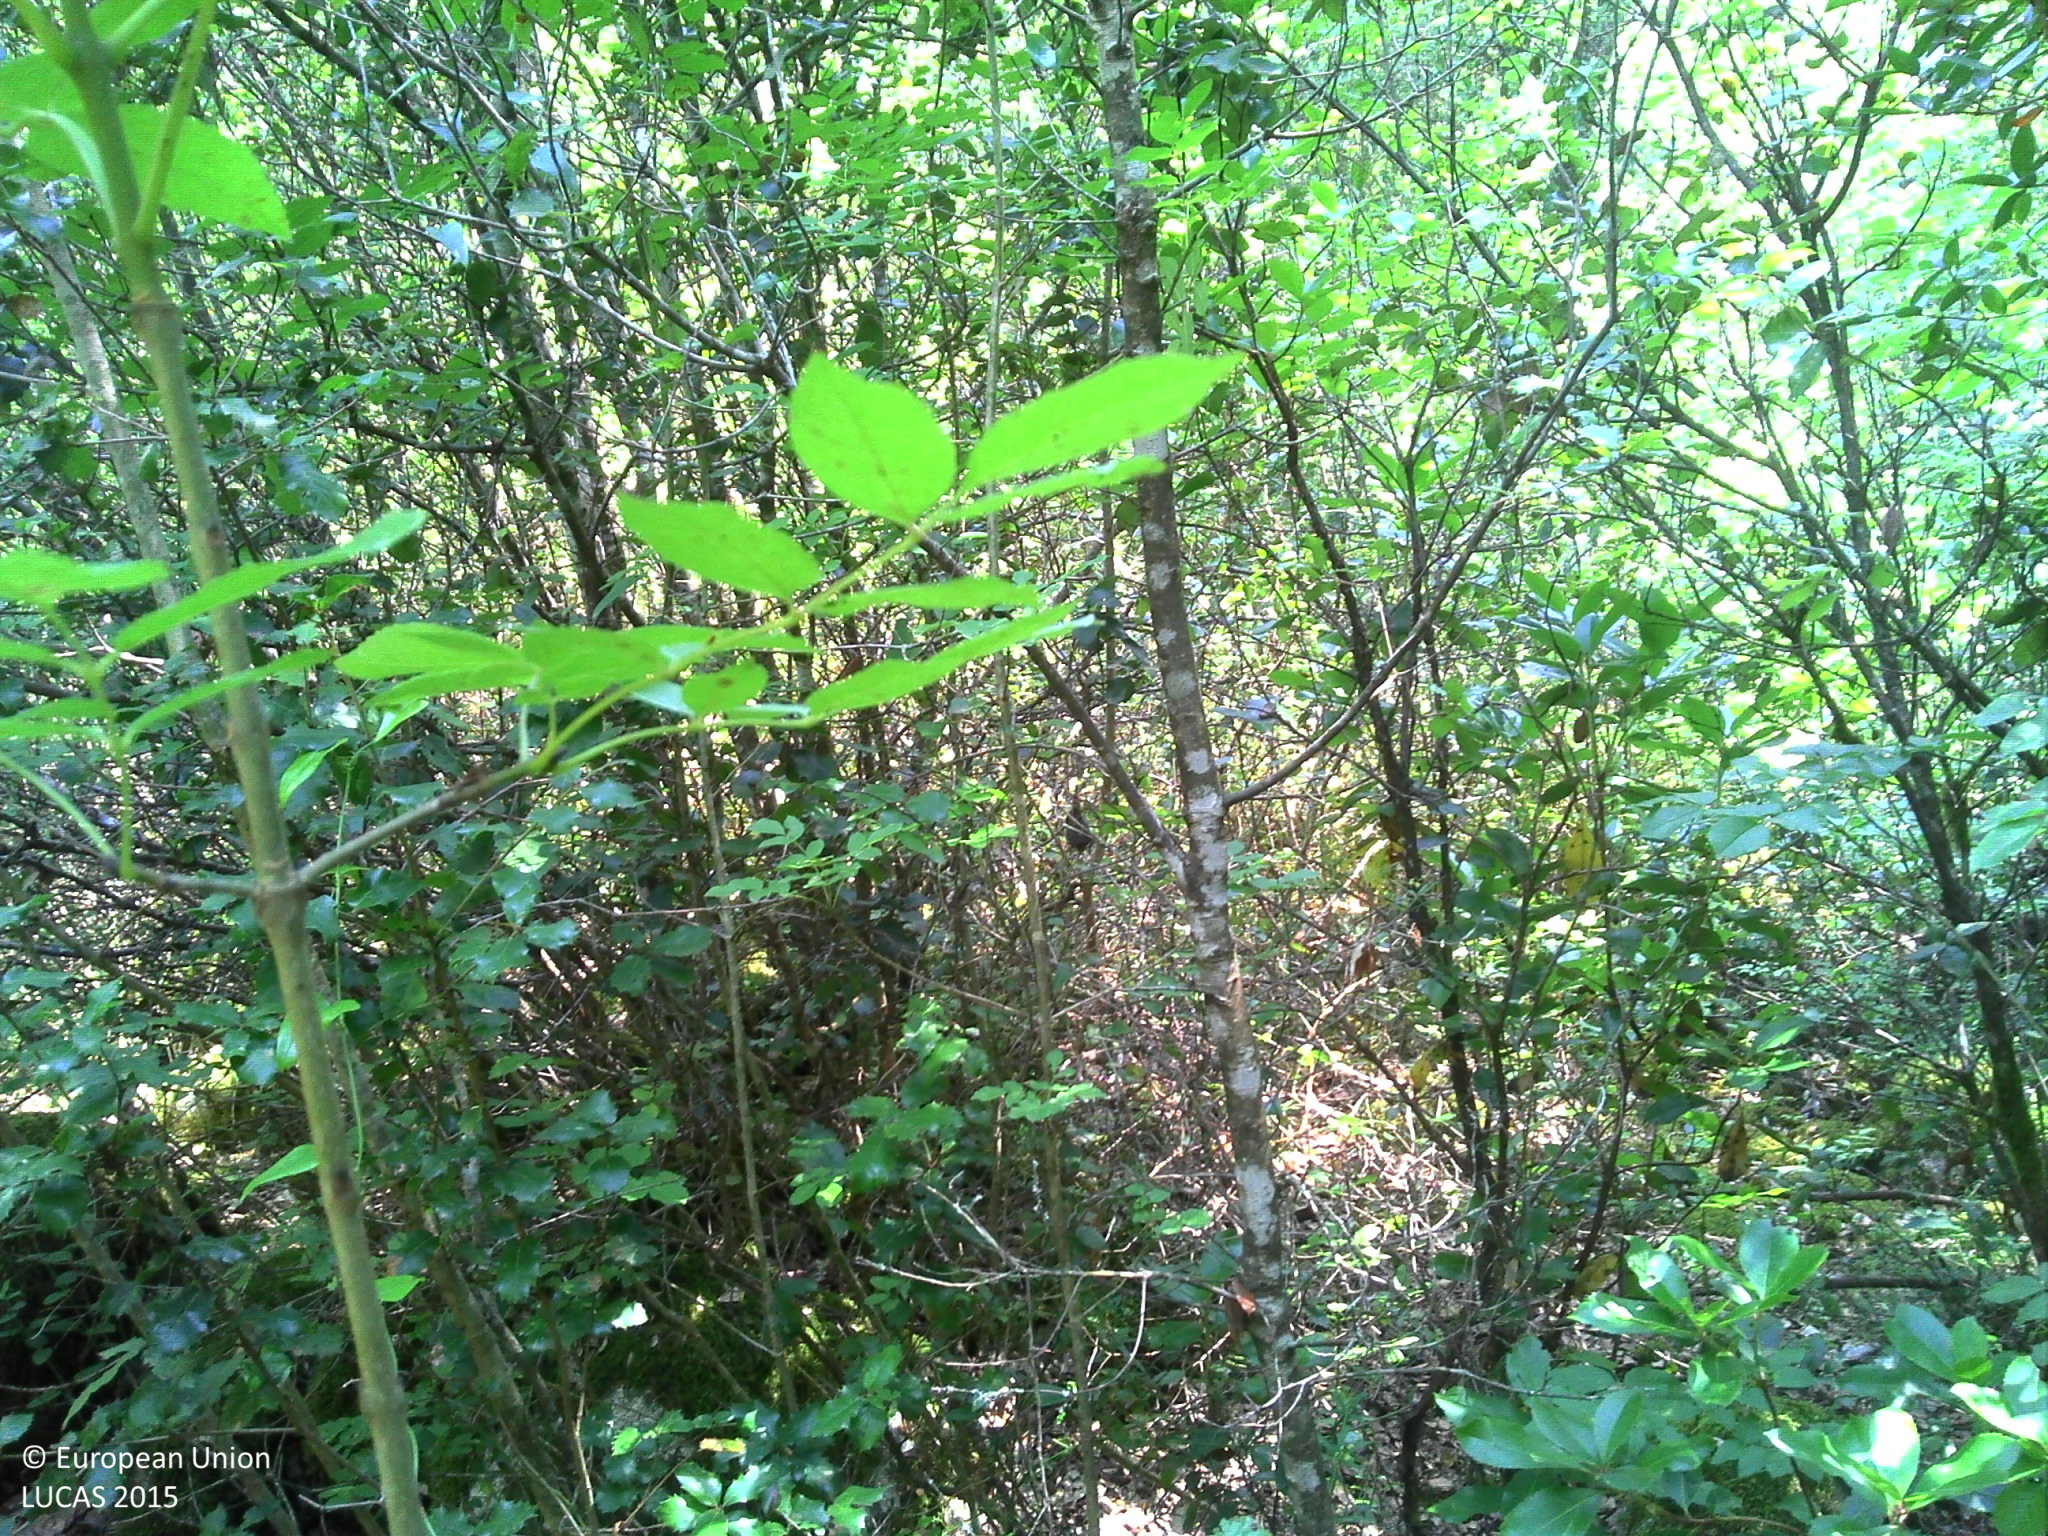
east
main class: Woodland
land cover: Broadleaved woodland
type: broadleaved evergreen forest
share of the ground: > 75 %
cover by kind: broadleaved forest trees 90 %, herbaceous plants 10 %
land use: Forestry
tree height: > 5 m
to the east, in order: Broadleaved woodland; Dry stone walls; Broadleaved woodland; Dry stone walls; Broadleaved woodland; Dry stone walls; Broadleaved woodland; Dry stone walls; Broadleaved woodland; Tracks; Broadleaved woodland; Dry stone walls; Broadleaved woodland; Dry stone walls; Broadleaved woodland; Dry stone walls; Broadleaved woodland; Dry stone walls; Tracks; Shruby margins; Fences; Broadleaved woodland
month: June
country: FR
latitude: 42.0895
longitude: 9.0485
